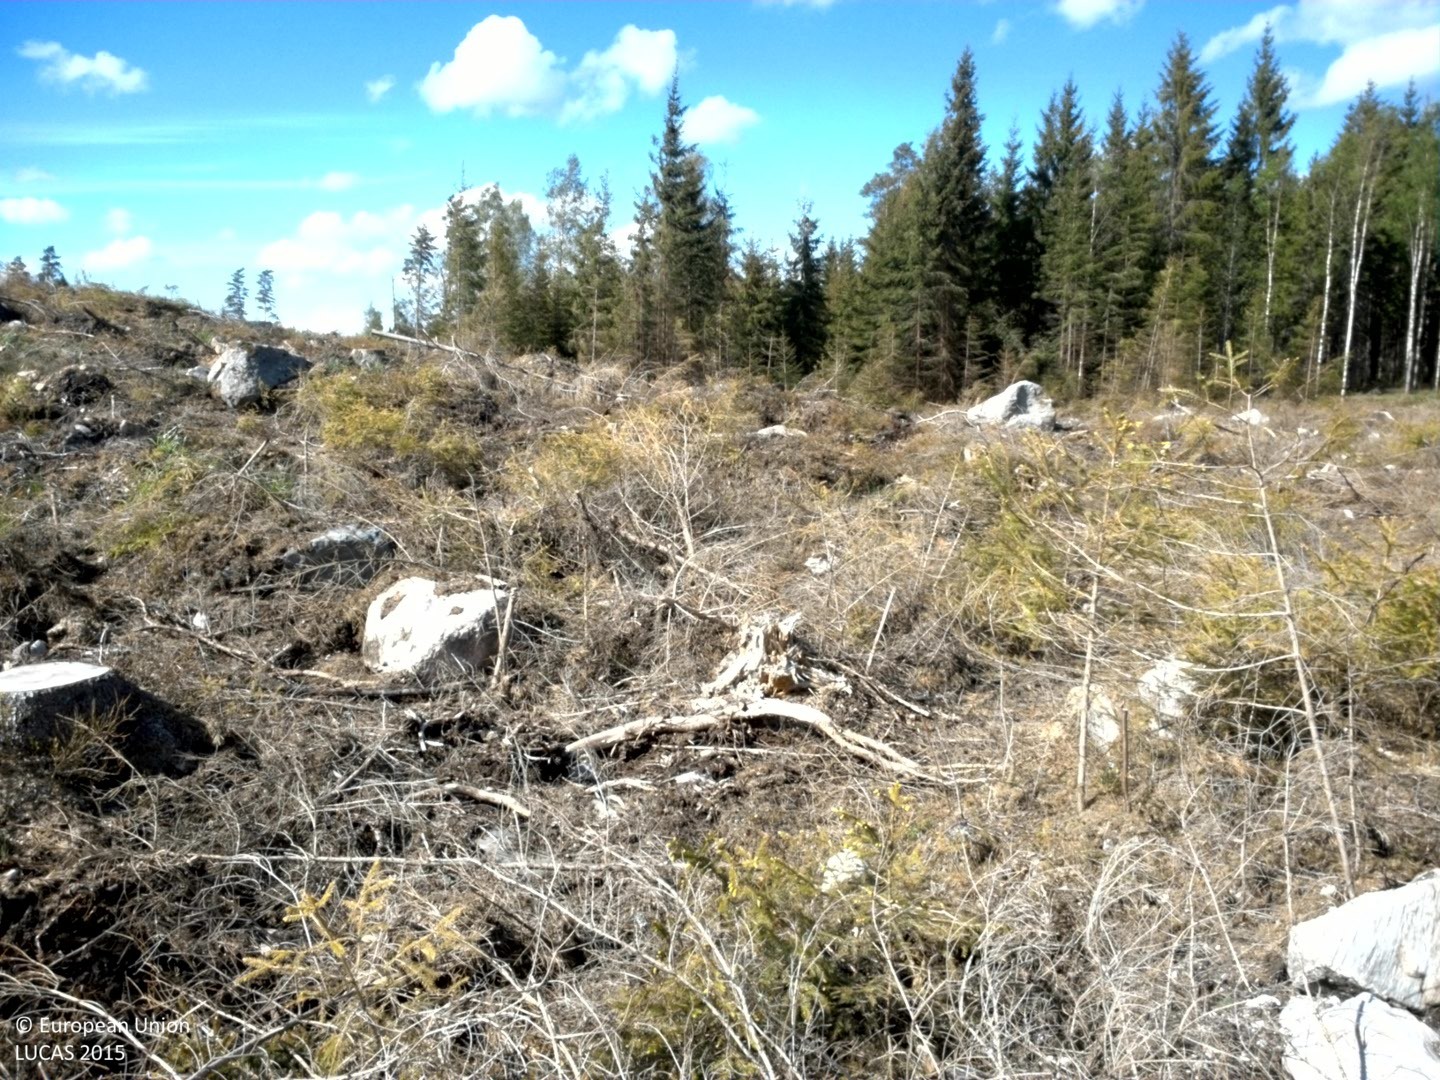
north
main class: Woodland
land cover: Spruce dominated coniferous woodland
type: boreal forest
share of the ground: 10 - 25 %
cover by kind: shrubs 75 %, lichens and mosses 15 %, coniferous forest trees 10 %
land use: Forestry
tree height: < 5 m
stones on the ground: 10 - 25 %
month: May
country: SE
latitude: 59.1023
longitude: 14.4092
